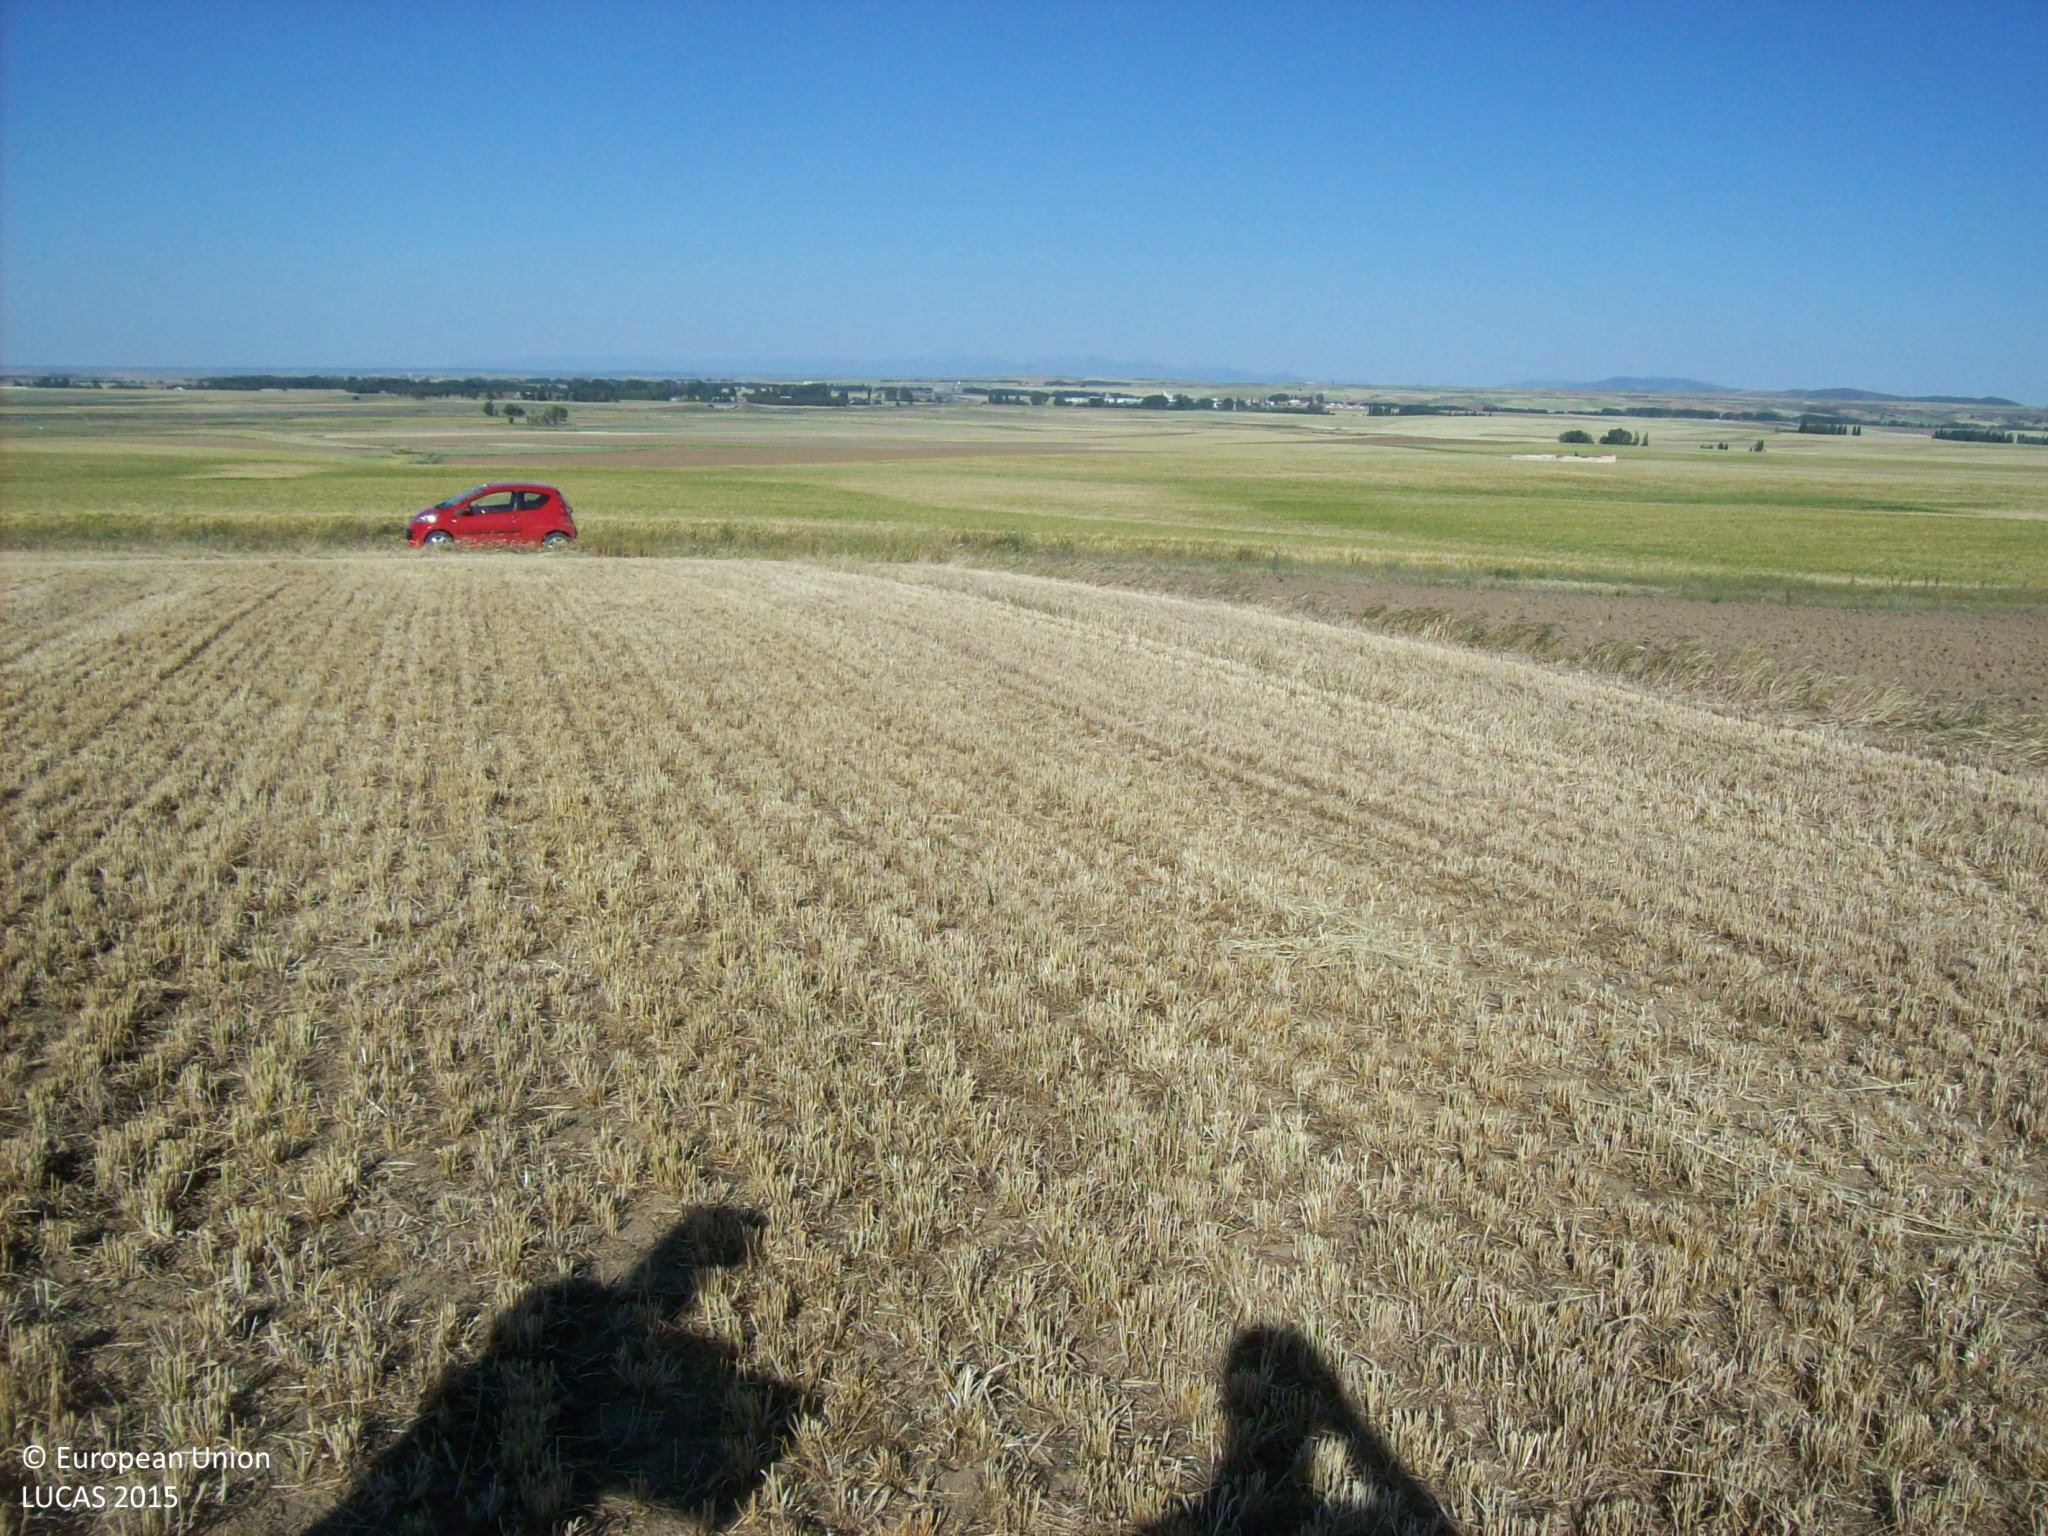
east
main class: Cropland
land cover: Oats
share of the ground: > 75 %
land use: Agriculture (excluding fallow land and kitchen gardens)
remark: Harvested field
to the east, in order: Oats; Other bare soil; Grass margins; Tracks; Grass margins; Barley; Grass margins; Barley
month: May
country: ES
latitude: 40.8054
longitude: -4.9380
